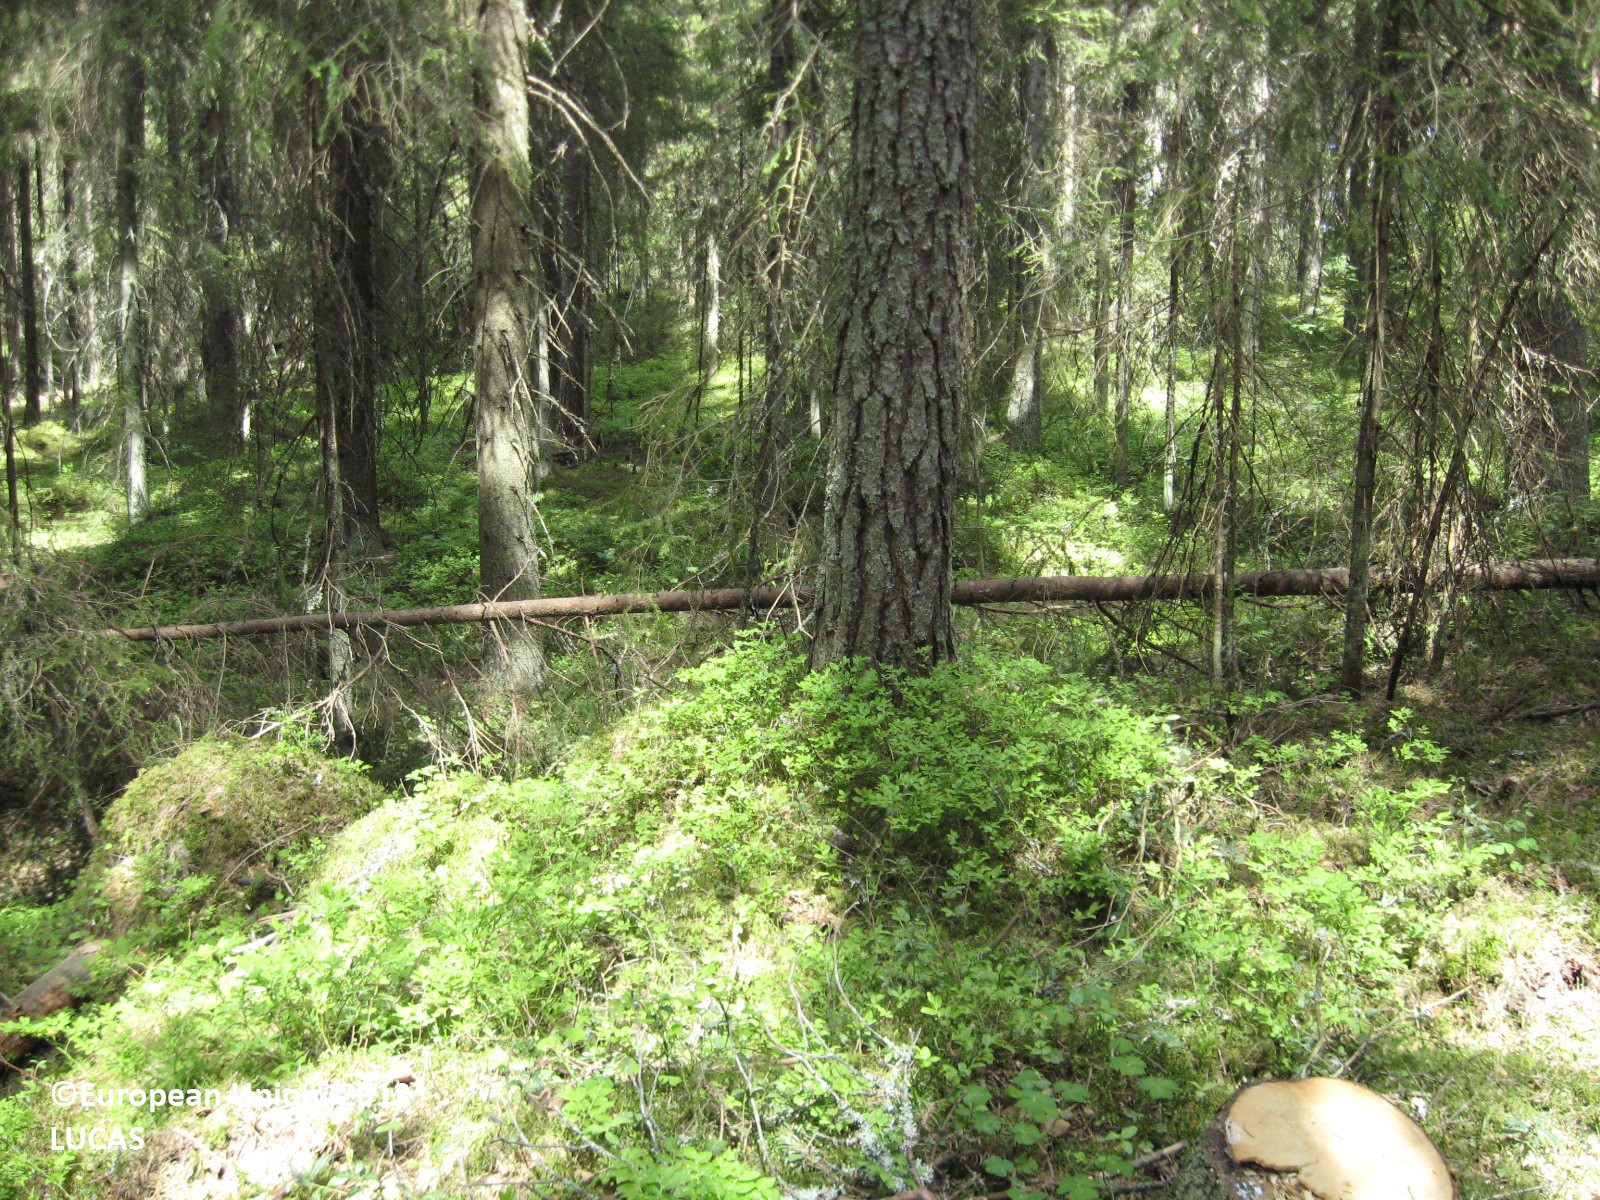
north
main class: Woodland
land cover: Spruce dominated coniferous woodland
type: boreal forest
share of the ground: > 75 %
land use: Forestry
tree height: > 5 m
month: May
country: FI
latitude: 61.7926
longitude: 22.3292
